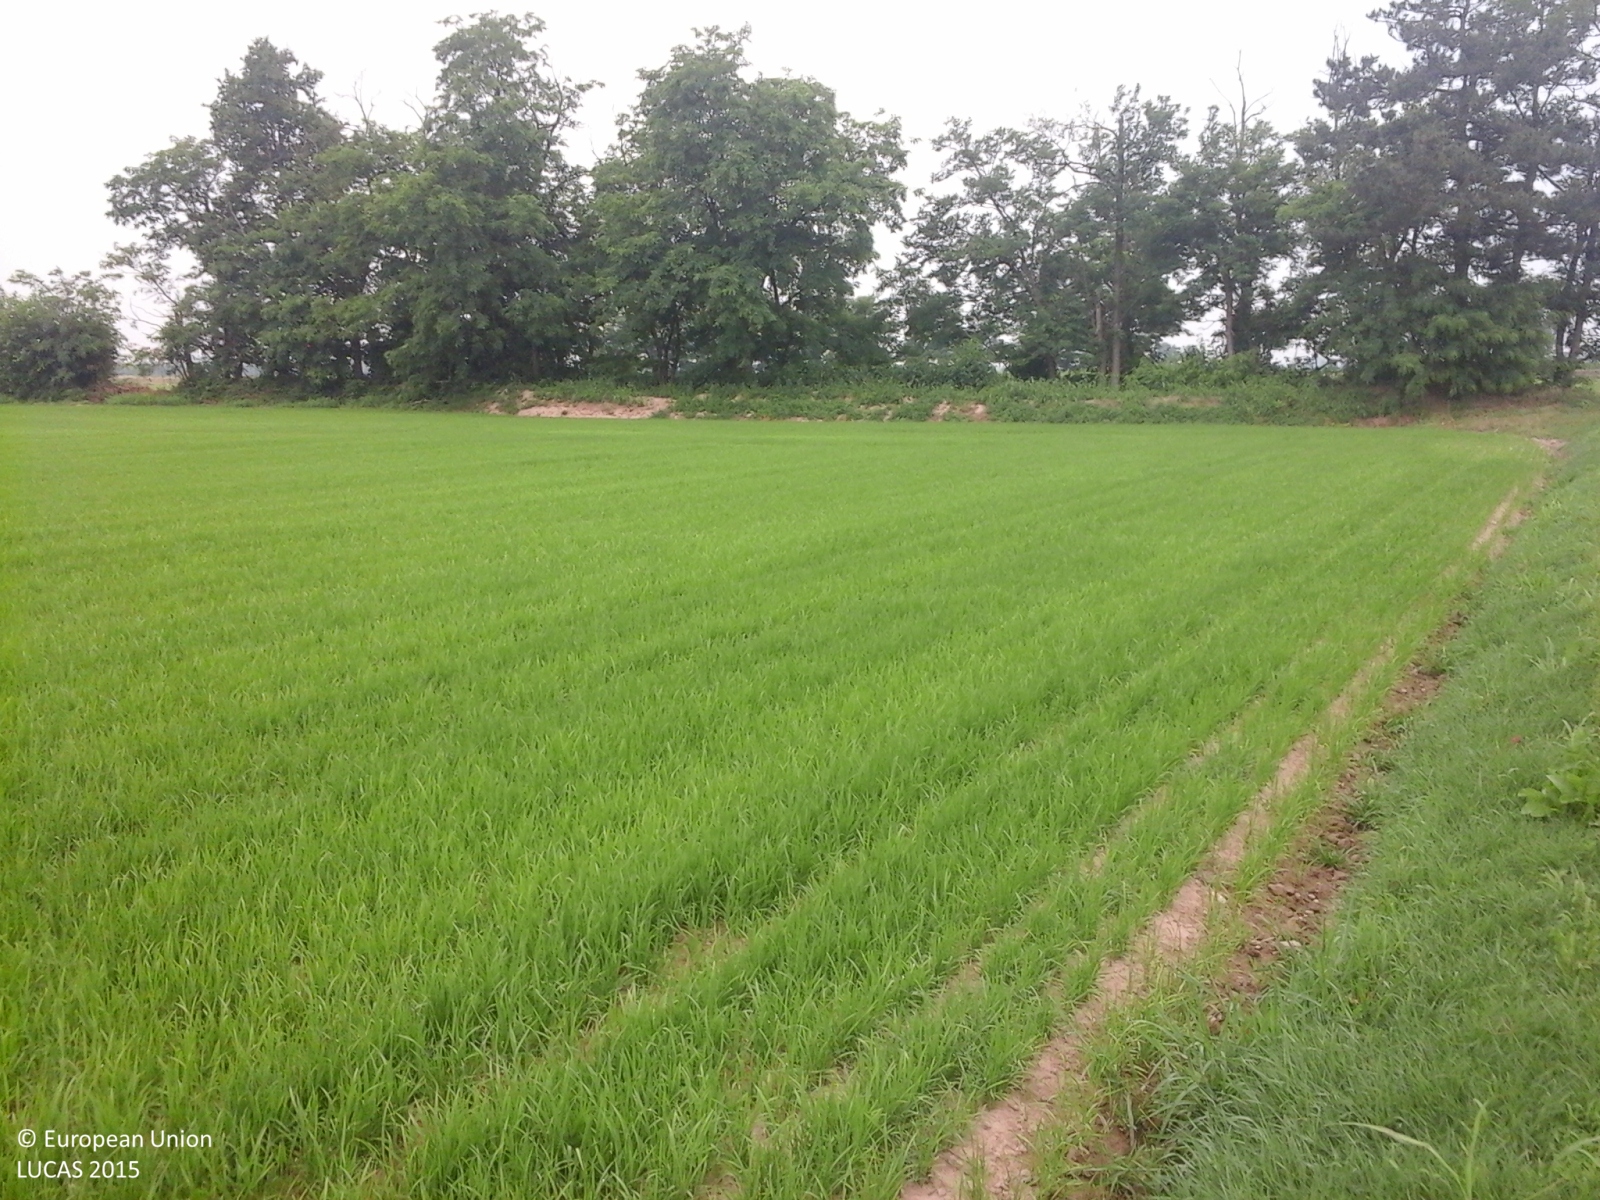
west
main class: Cropland
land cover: Rice
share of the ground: > 75 %
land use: Agriculture (excluding fallow land and kitchen gardens)
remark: Temporary flooded
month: June
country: IT
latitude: 45.1373
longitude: 8.8196
